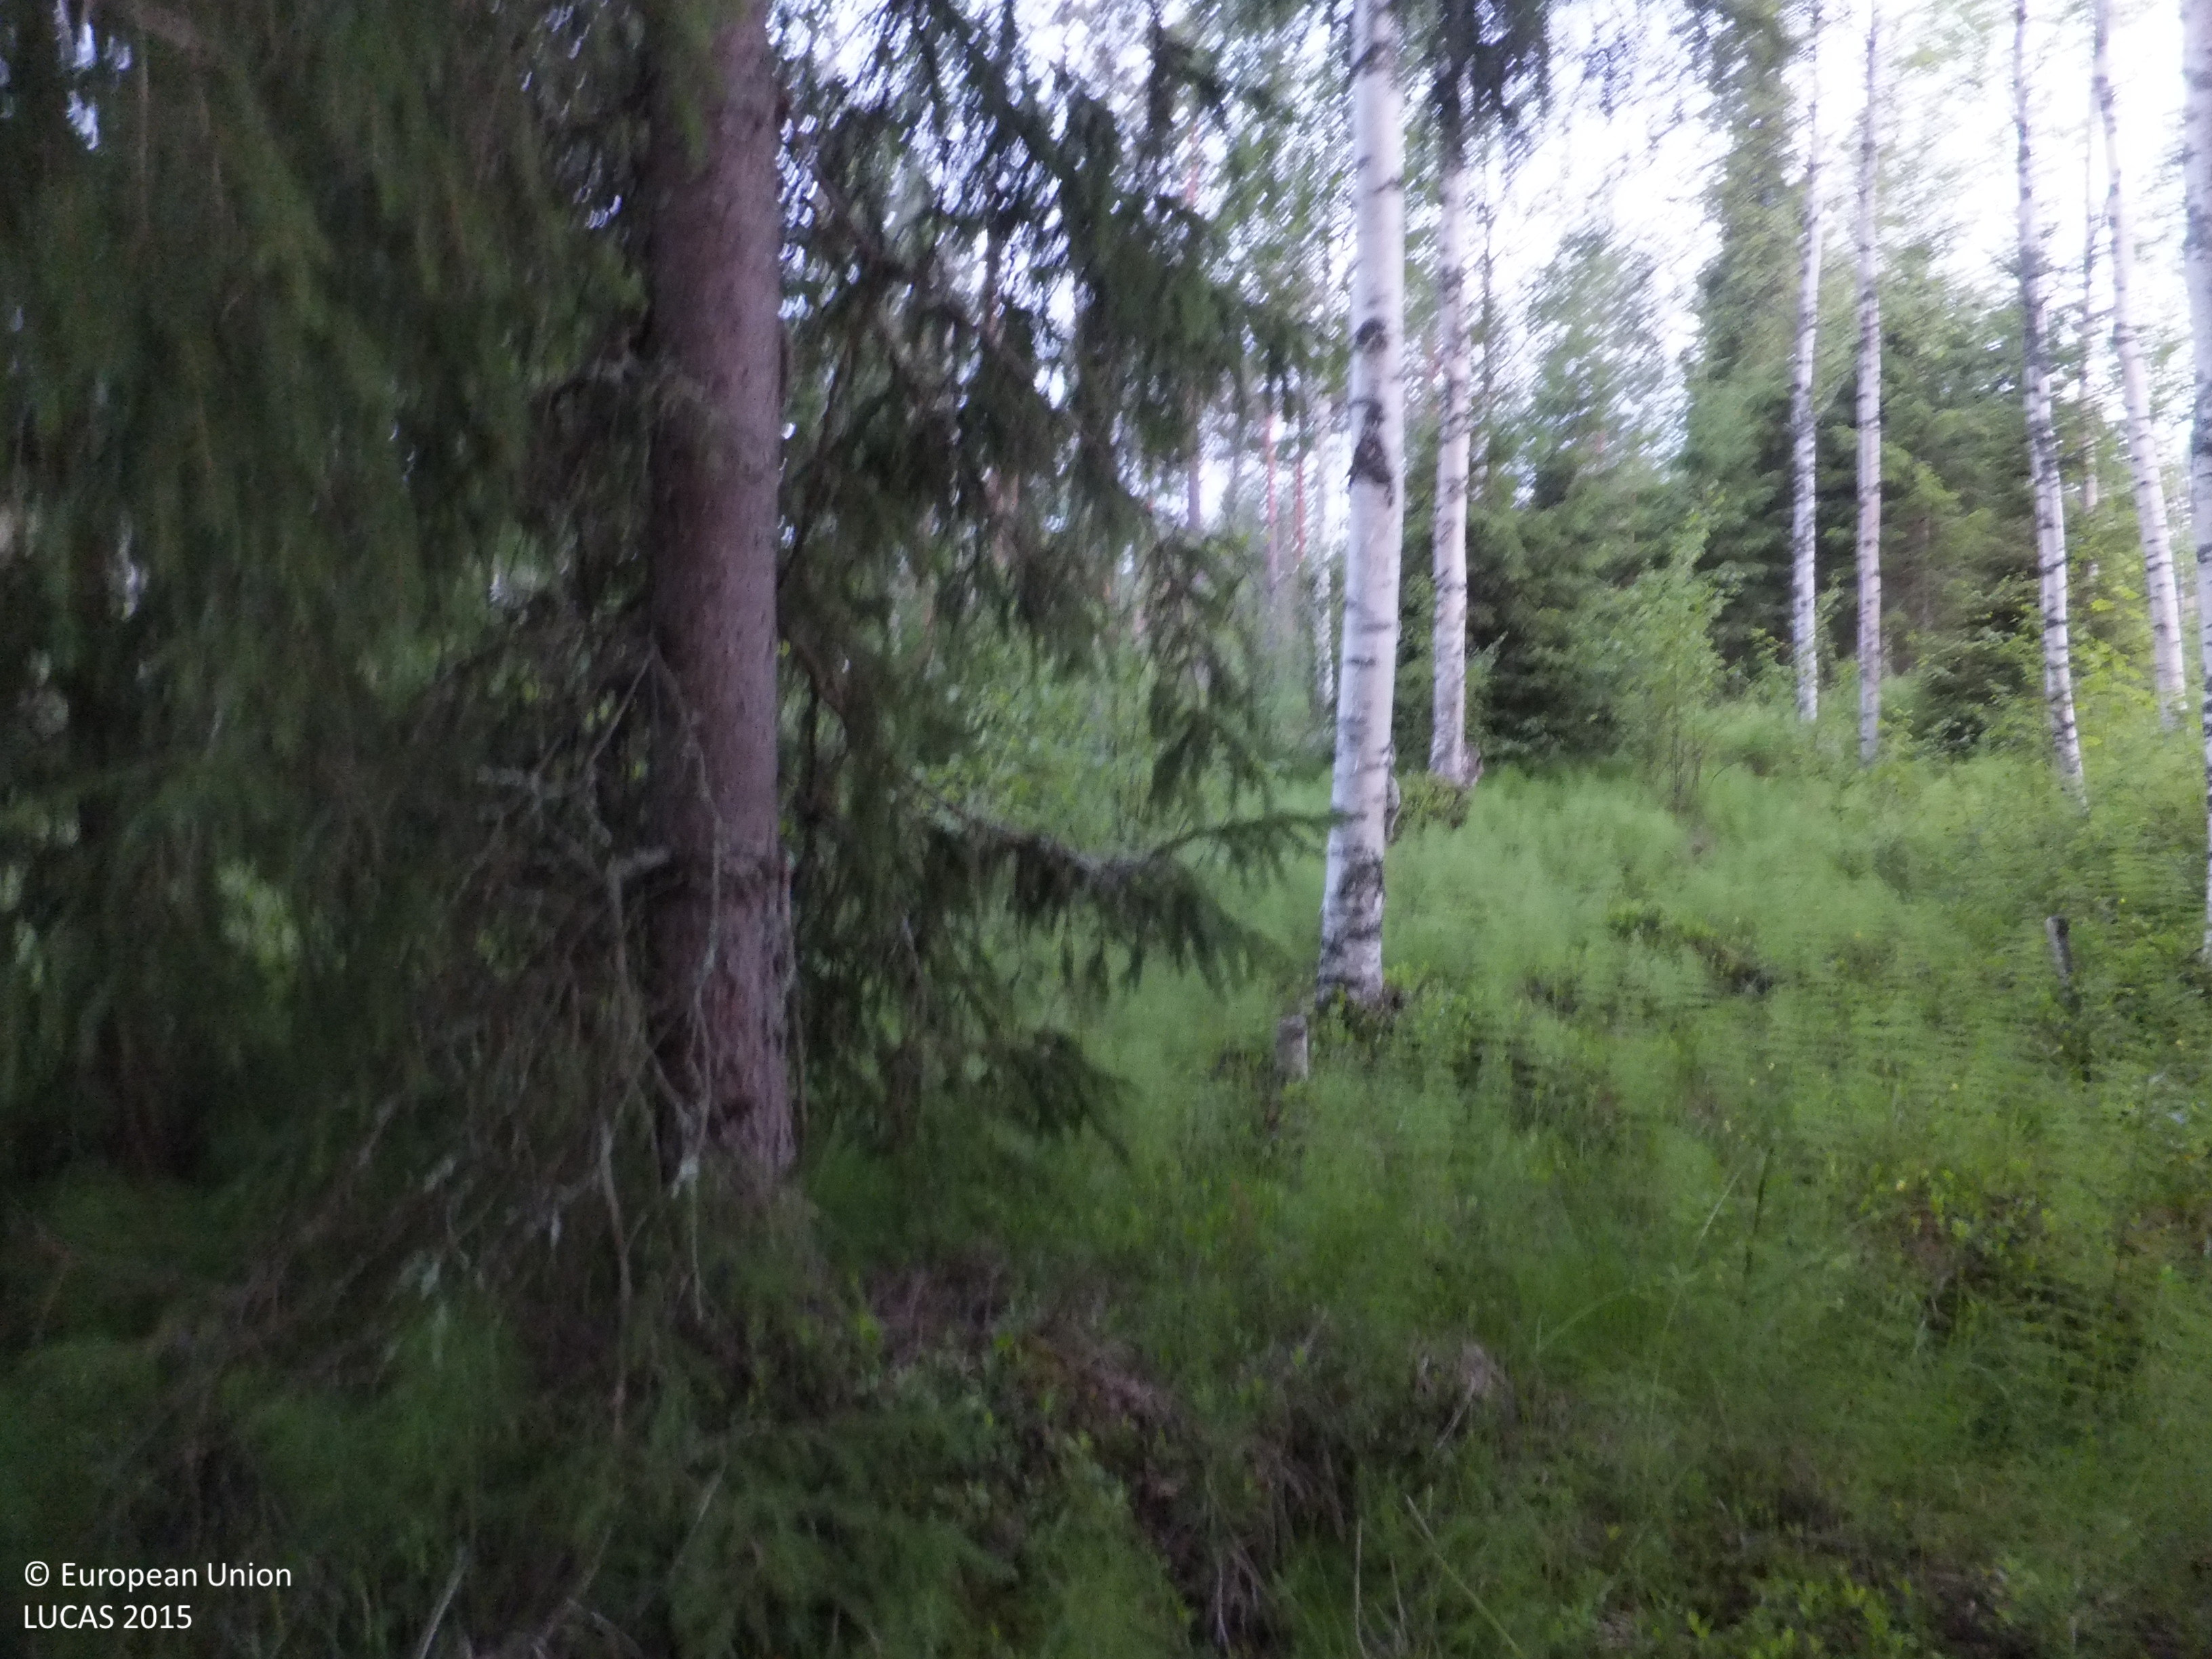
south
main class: Woodland
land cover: Spruce dominated mixed woodland
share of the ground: > 75 %
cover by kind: coniferous forest trees 40 %, broadleaved forest trees 40 %, shrubs 10 %, herbaceous plants 5 %, lichens and mosses 5 %
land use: Forestry
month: July
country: FI
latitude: 63.1162
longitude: 24.5351
